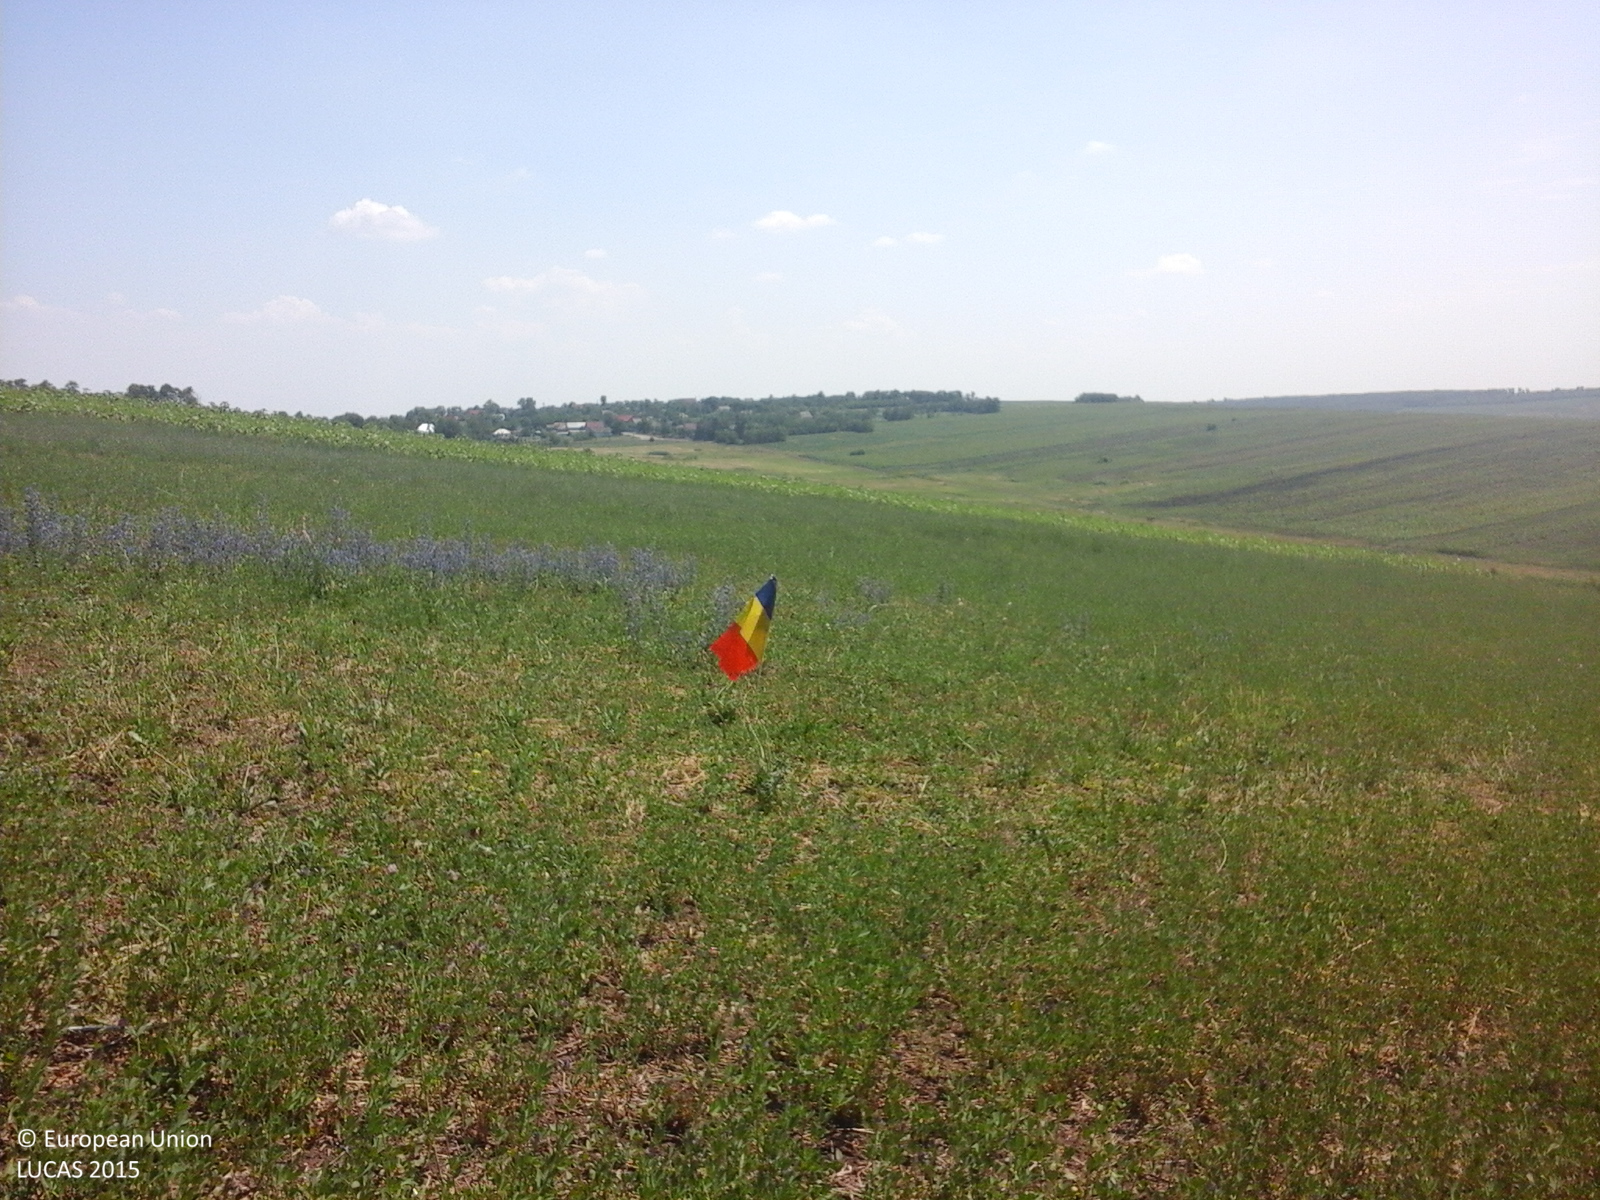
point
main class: Cropland
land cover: Lucerne
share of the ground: 50 - 75 %
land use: Agriculture (excluding fallow land and kitchen gardens)
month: June
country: RO
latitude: 47.4328
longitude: 27.1713
